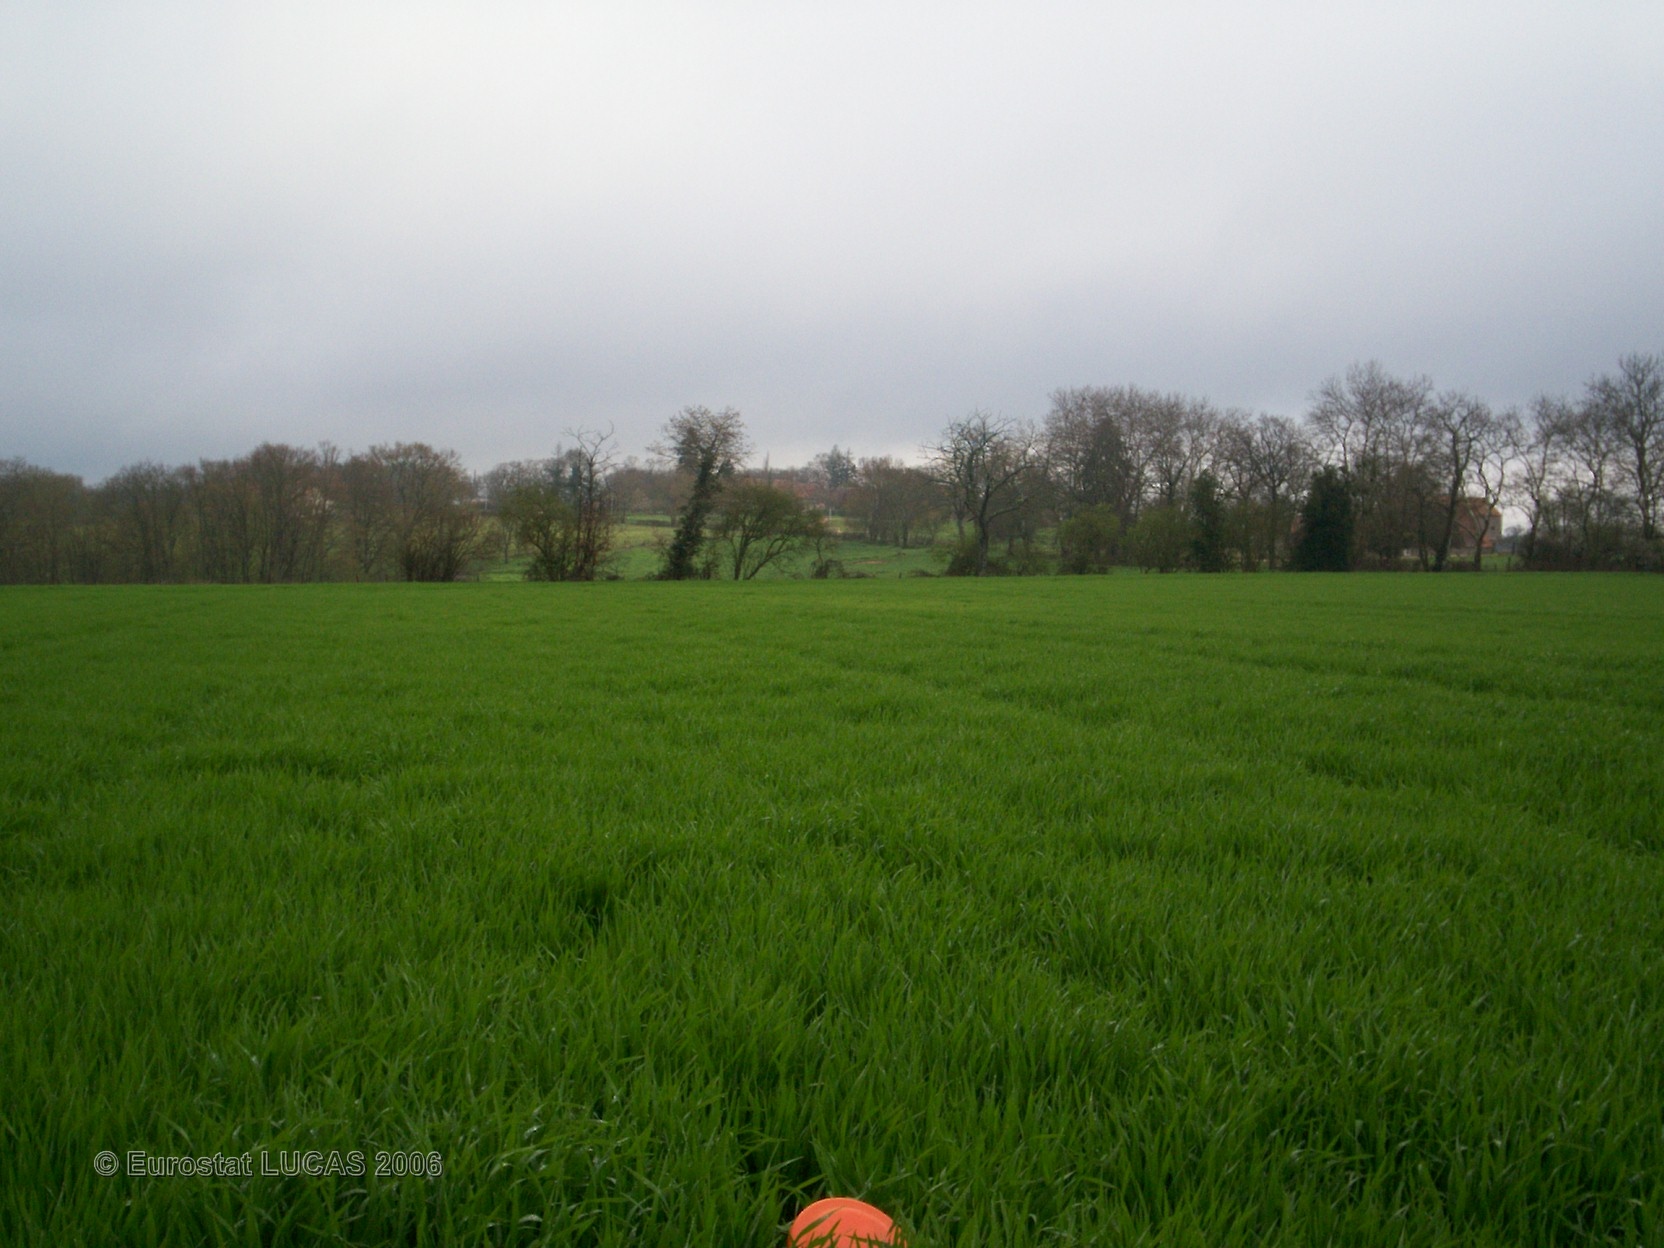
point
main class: Cropland
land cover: Common wheat
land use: Agriculture (excluding fallow land and kitchen gardens)
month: April
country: FR
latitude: 46.3880
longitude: 1.0013
